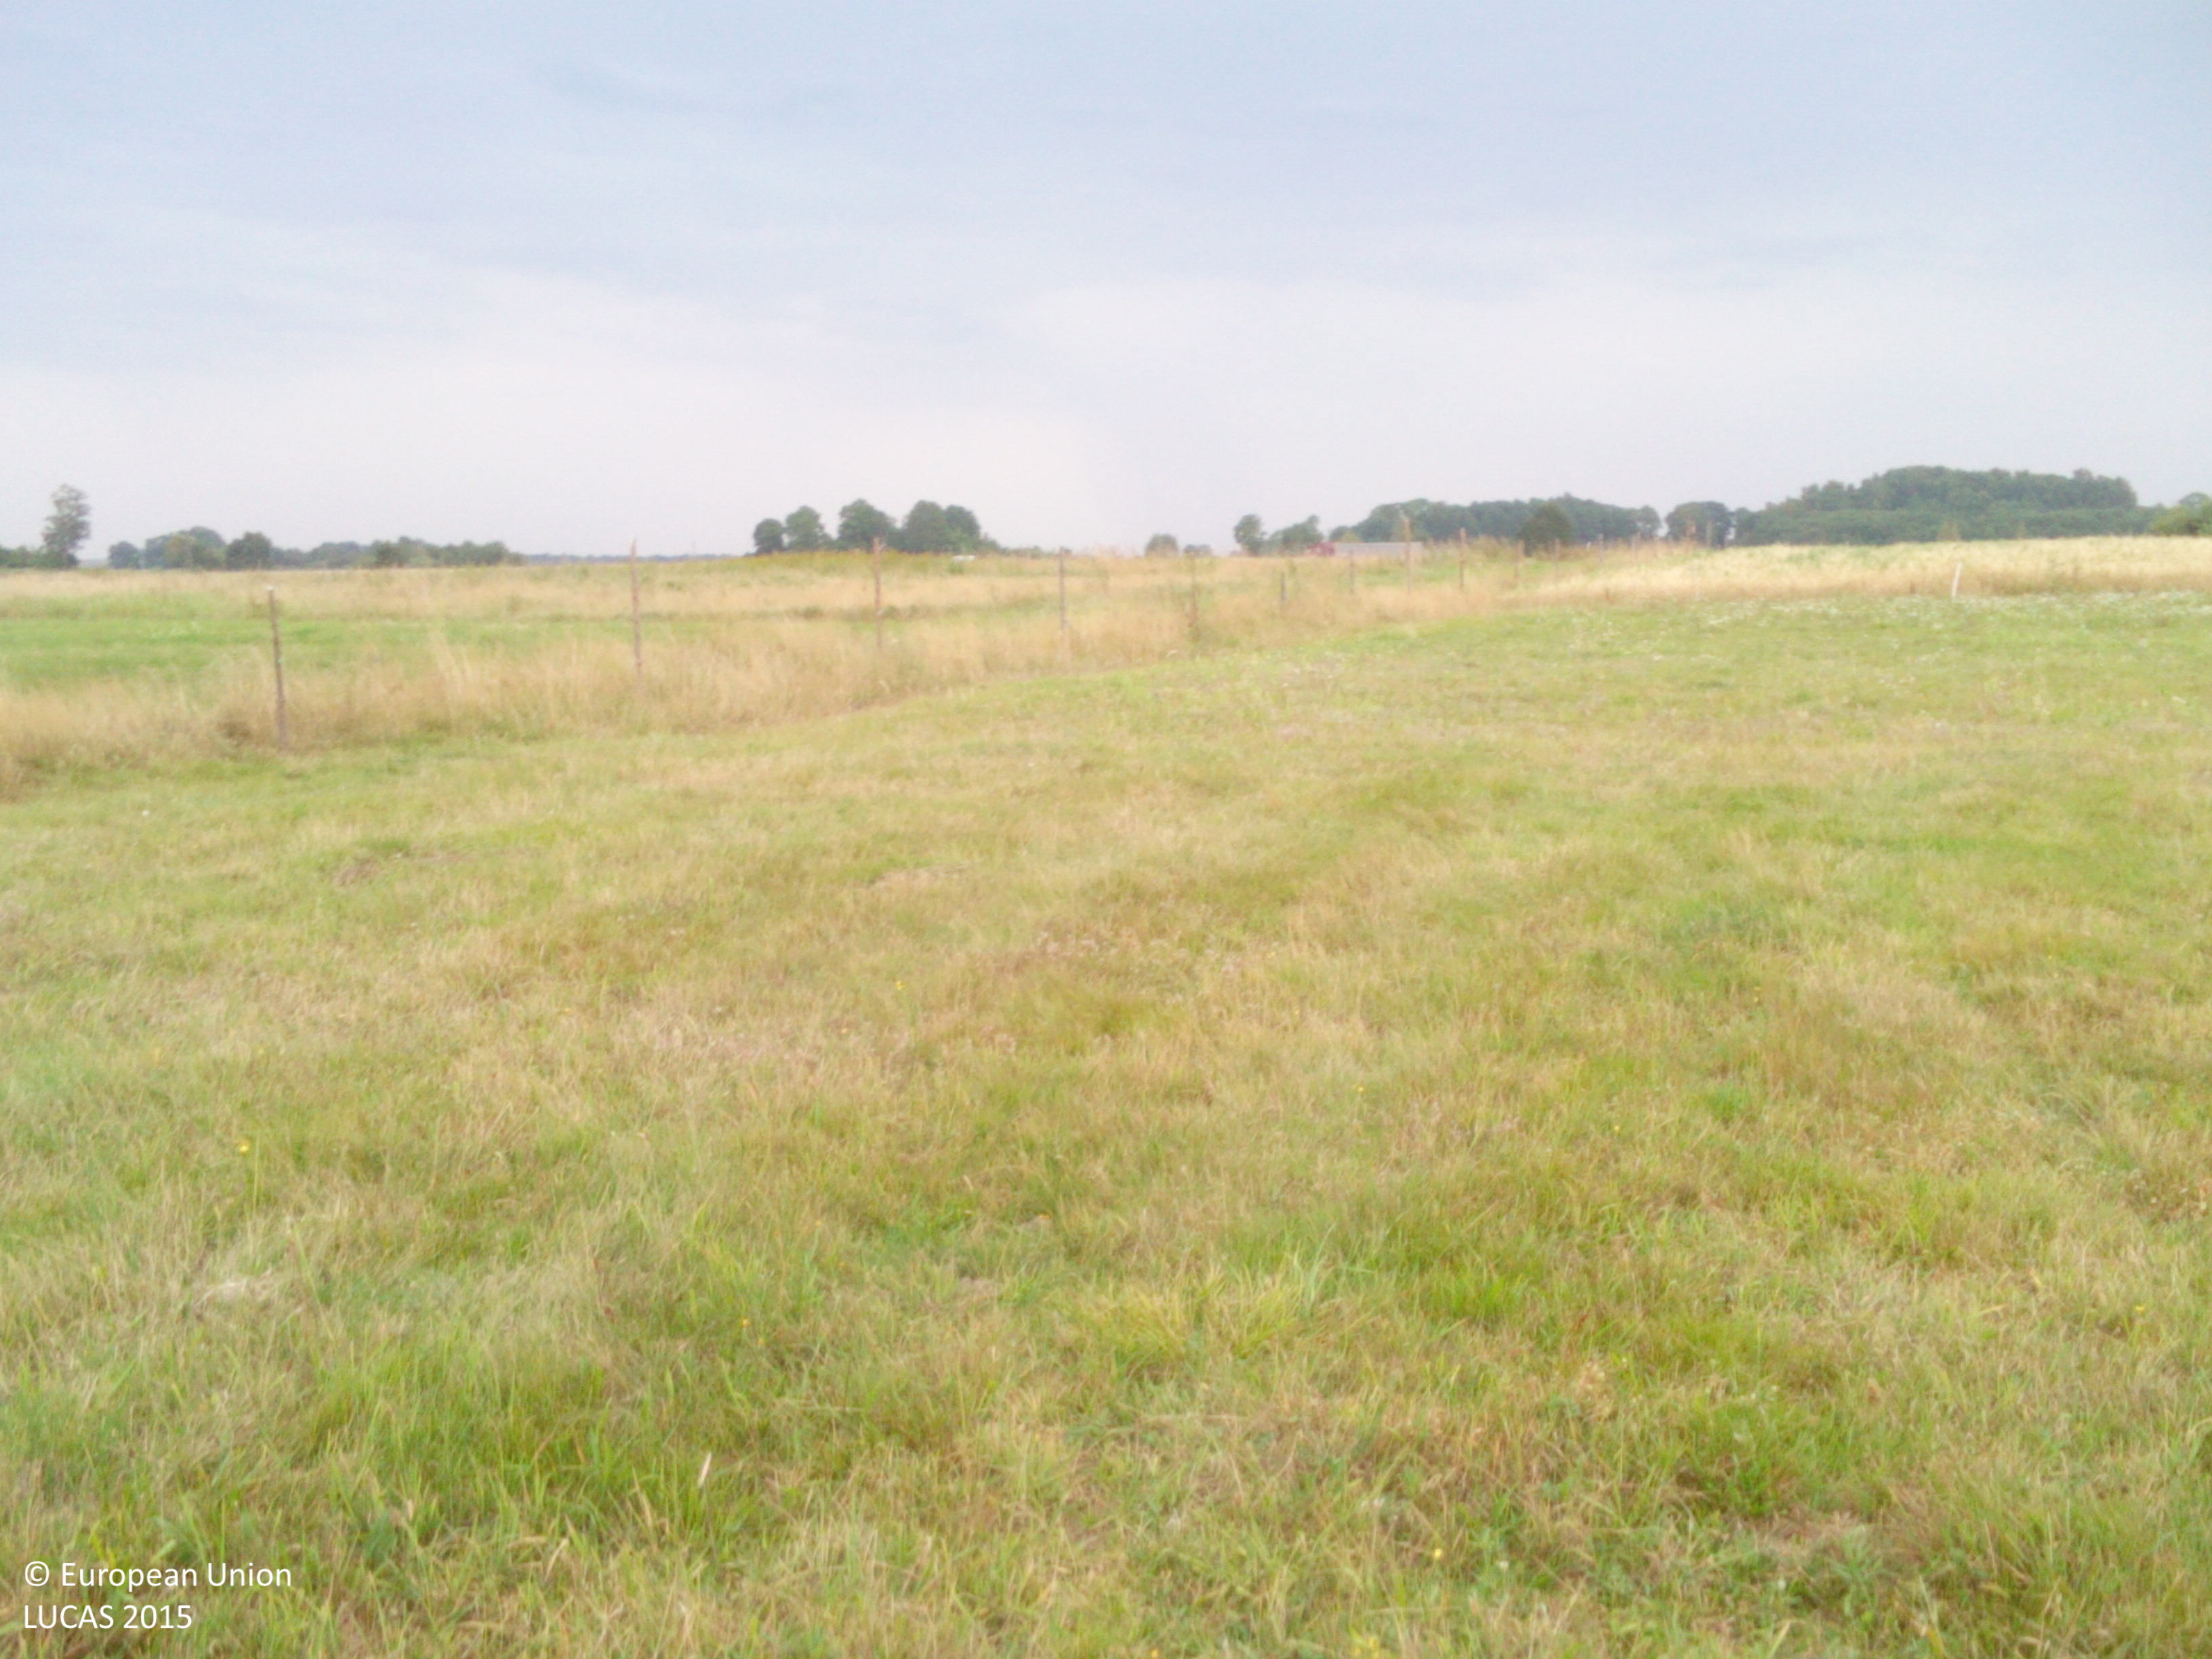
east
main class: Grassland
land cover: Grassland without tree/shrub cover
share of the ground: > 75 %
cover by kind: herbaceous plants 100 %
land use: Agriculture (excluding fallow land and kitchen gardens)
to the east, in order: Grassland without tree/shrub cover; Fences; Grassland without tree/shrub cover; Fences; Grassland without tree/shrub cover
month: August
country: LV
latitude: 56.1710
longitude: 21.1683
